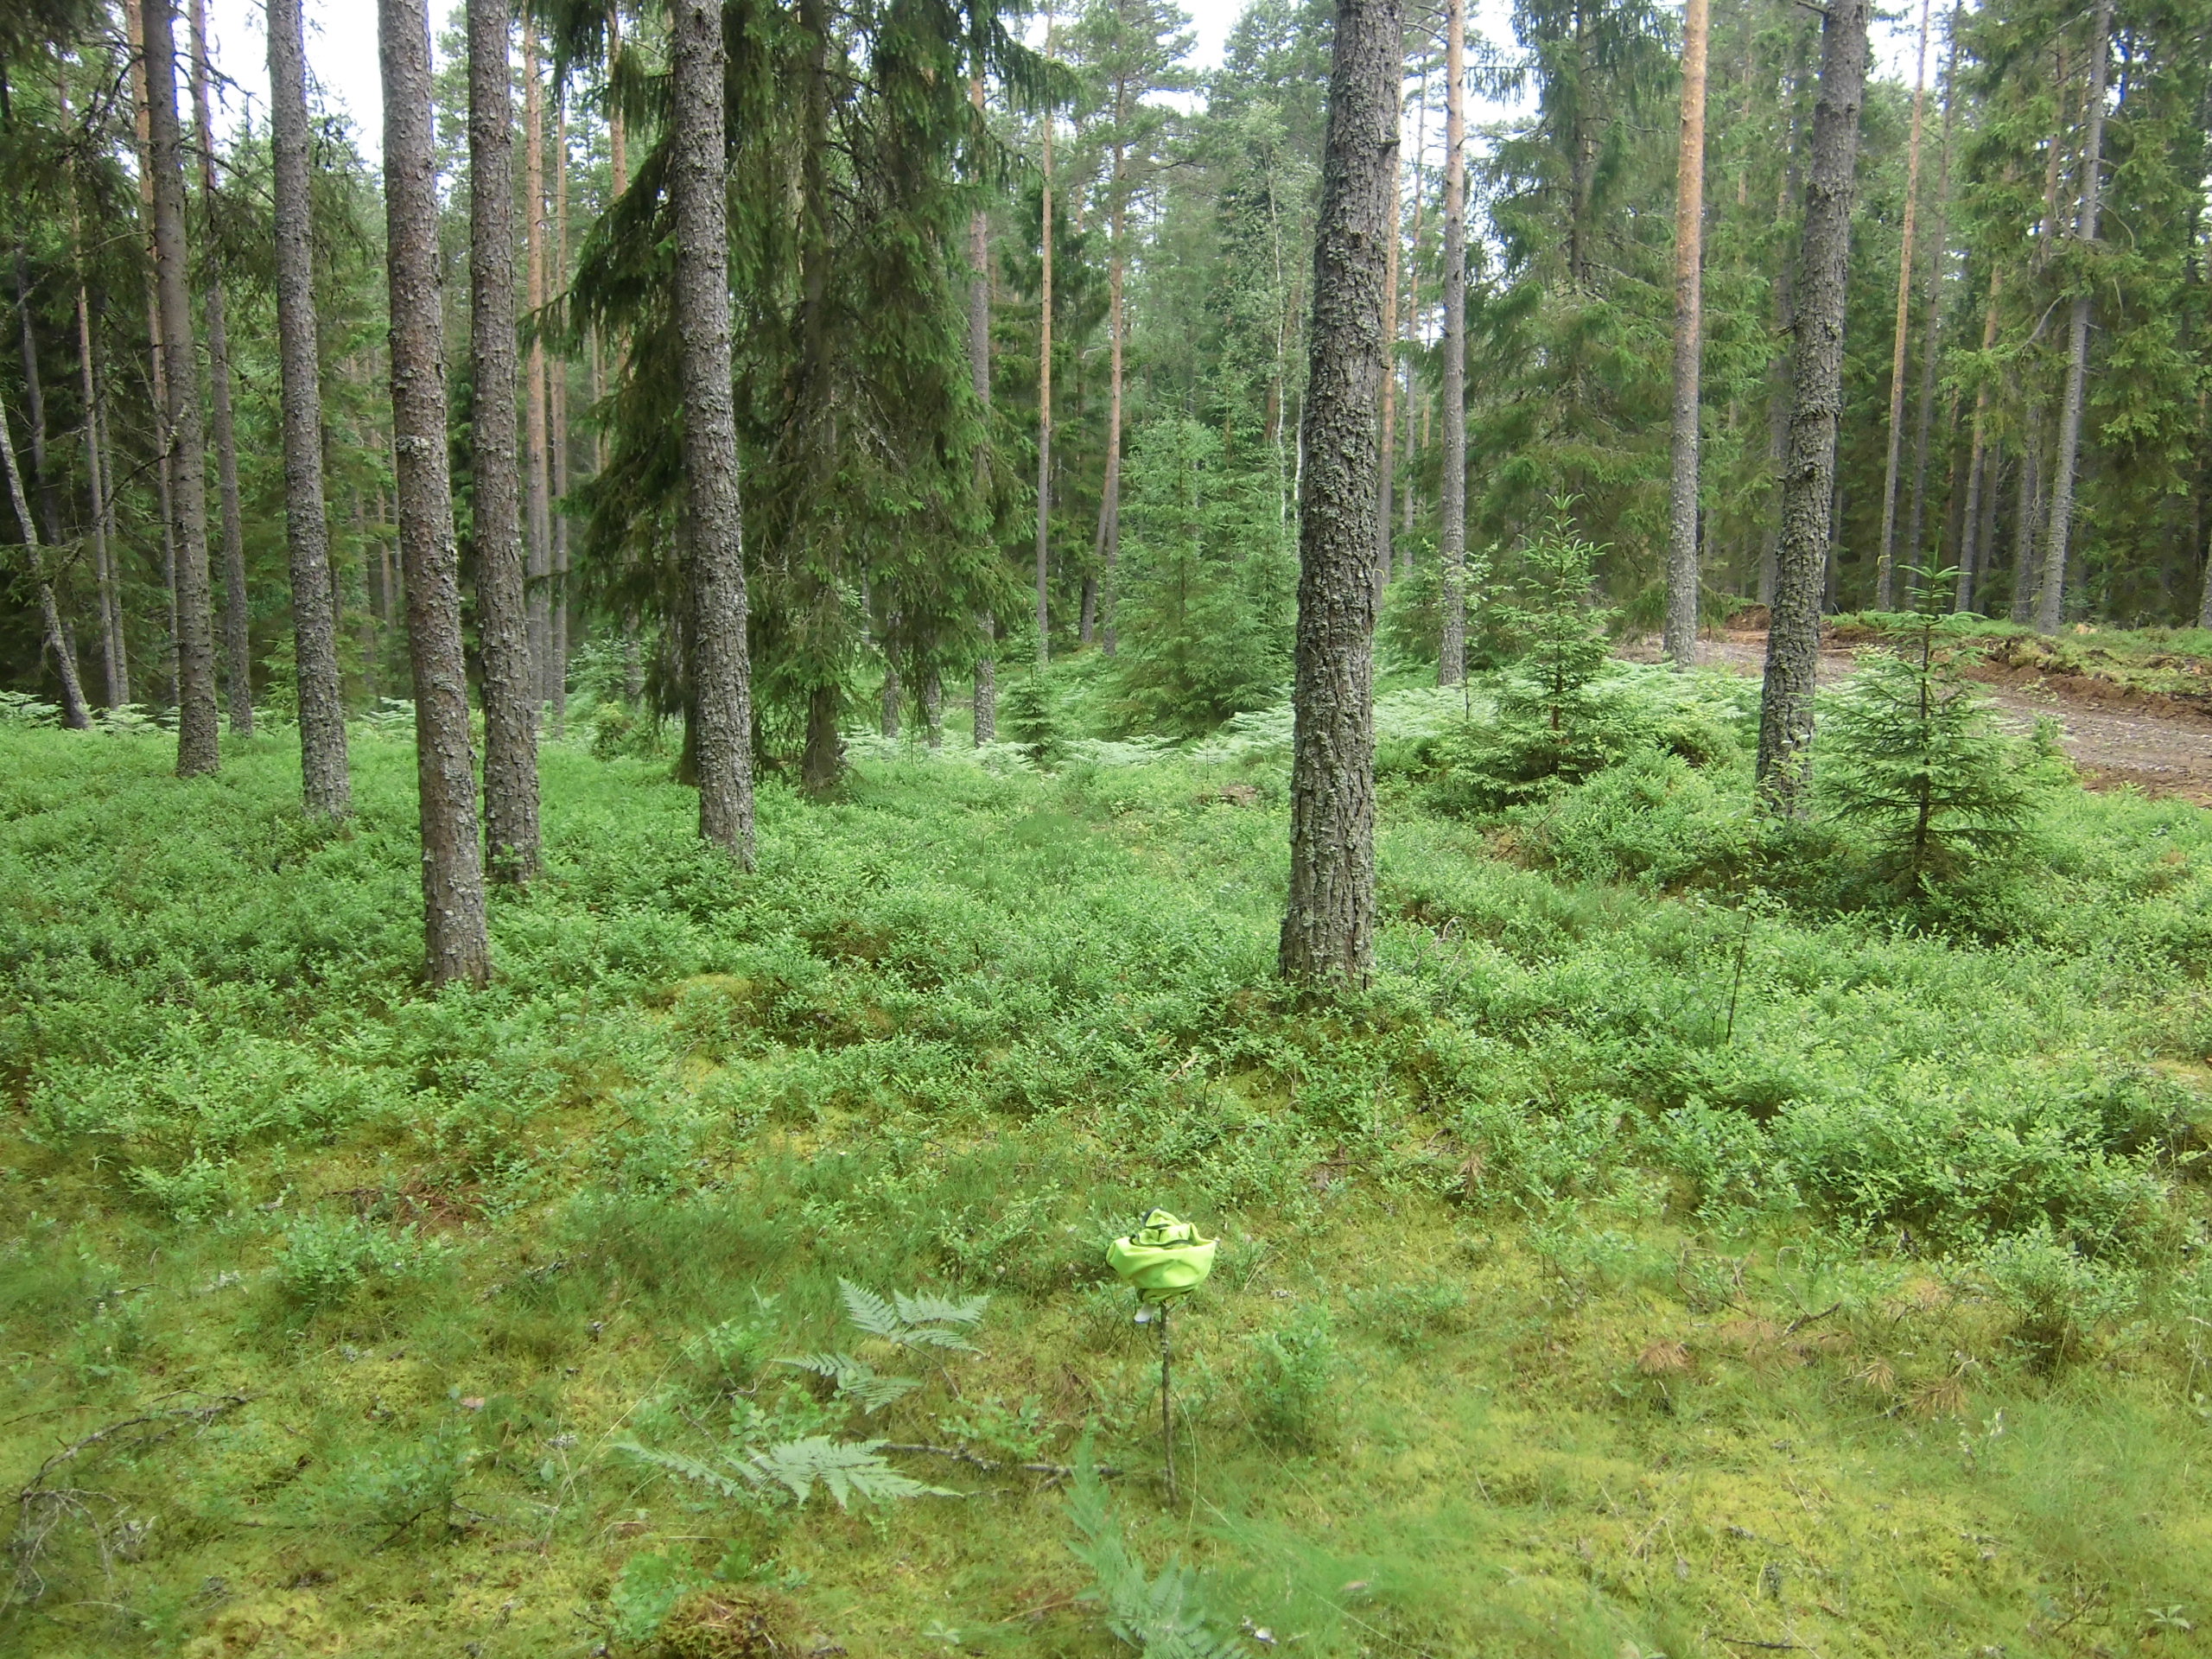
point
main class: Woodland
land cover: Pine dominated coniferous woodland
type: boreal forest
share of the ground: 25 - 50 %
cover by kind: coniferous forest trees 45 %, shrubs 25 %, lichens and mosses 15 %, herbaceous plants 10 %, broadleaved forest trees 5 %
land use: Forestry
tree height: > 5 m
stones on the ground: 10 - 25 %
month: July
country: SE
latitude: 57.3183
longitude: 14.9280
